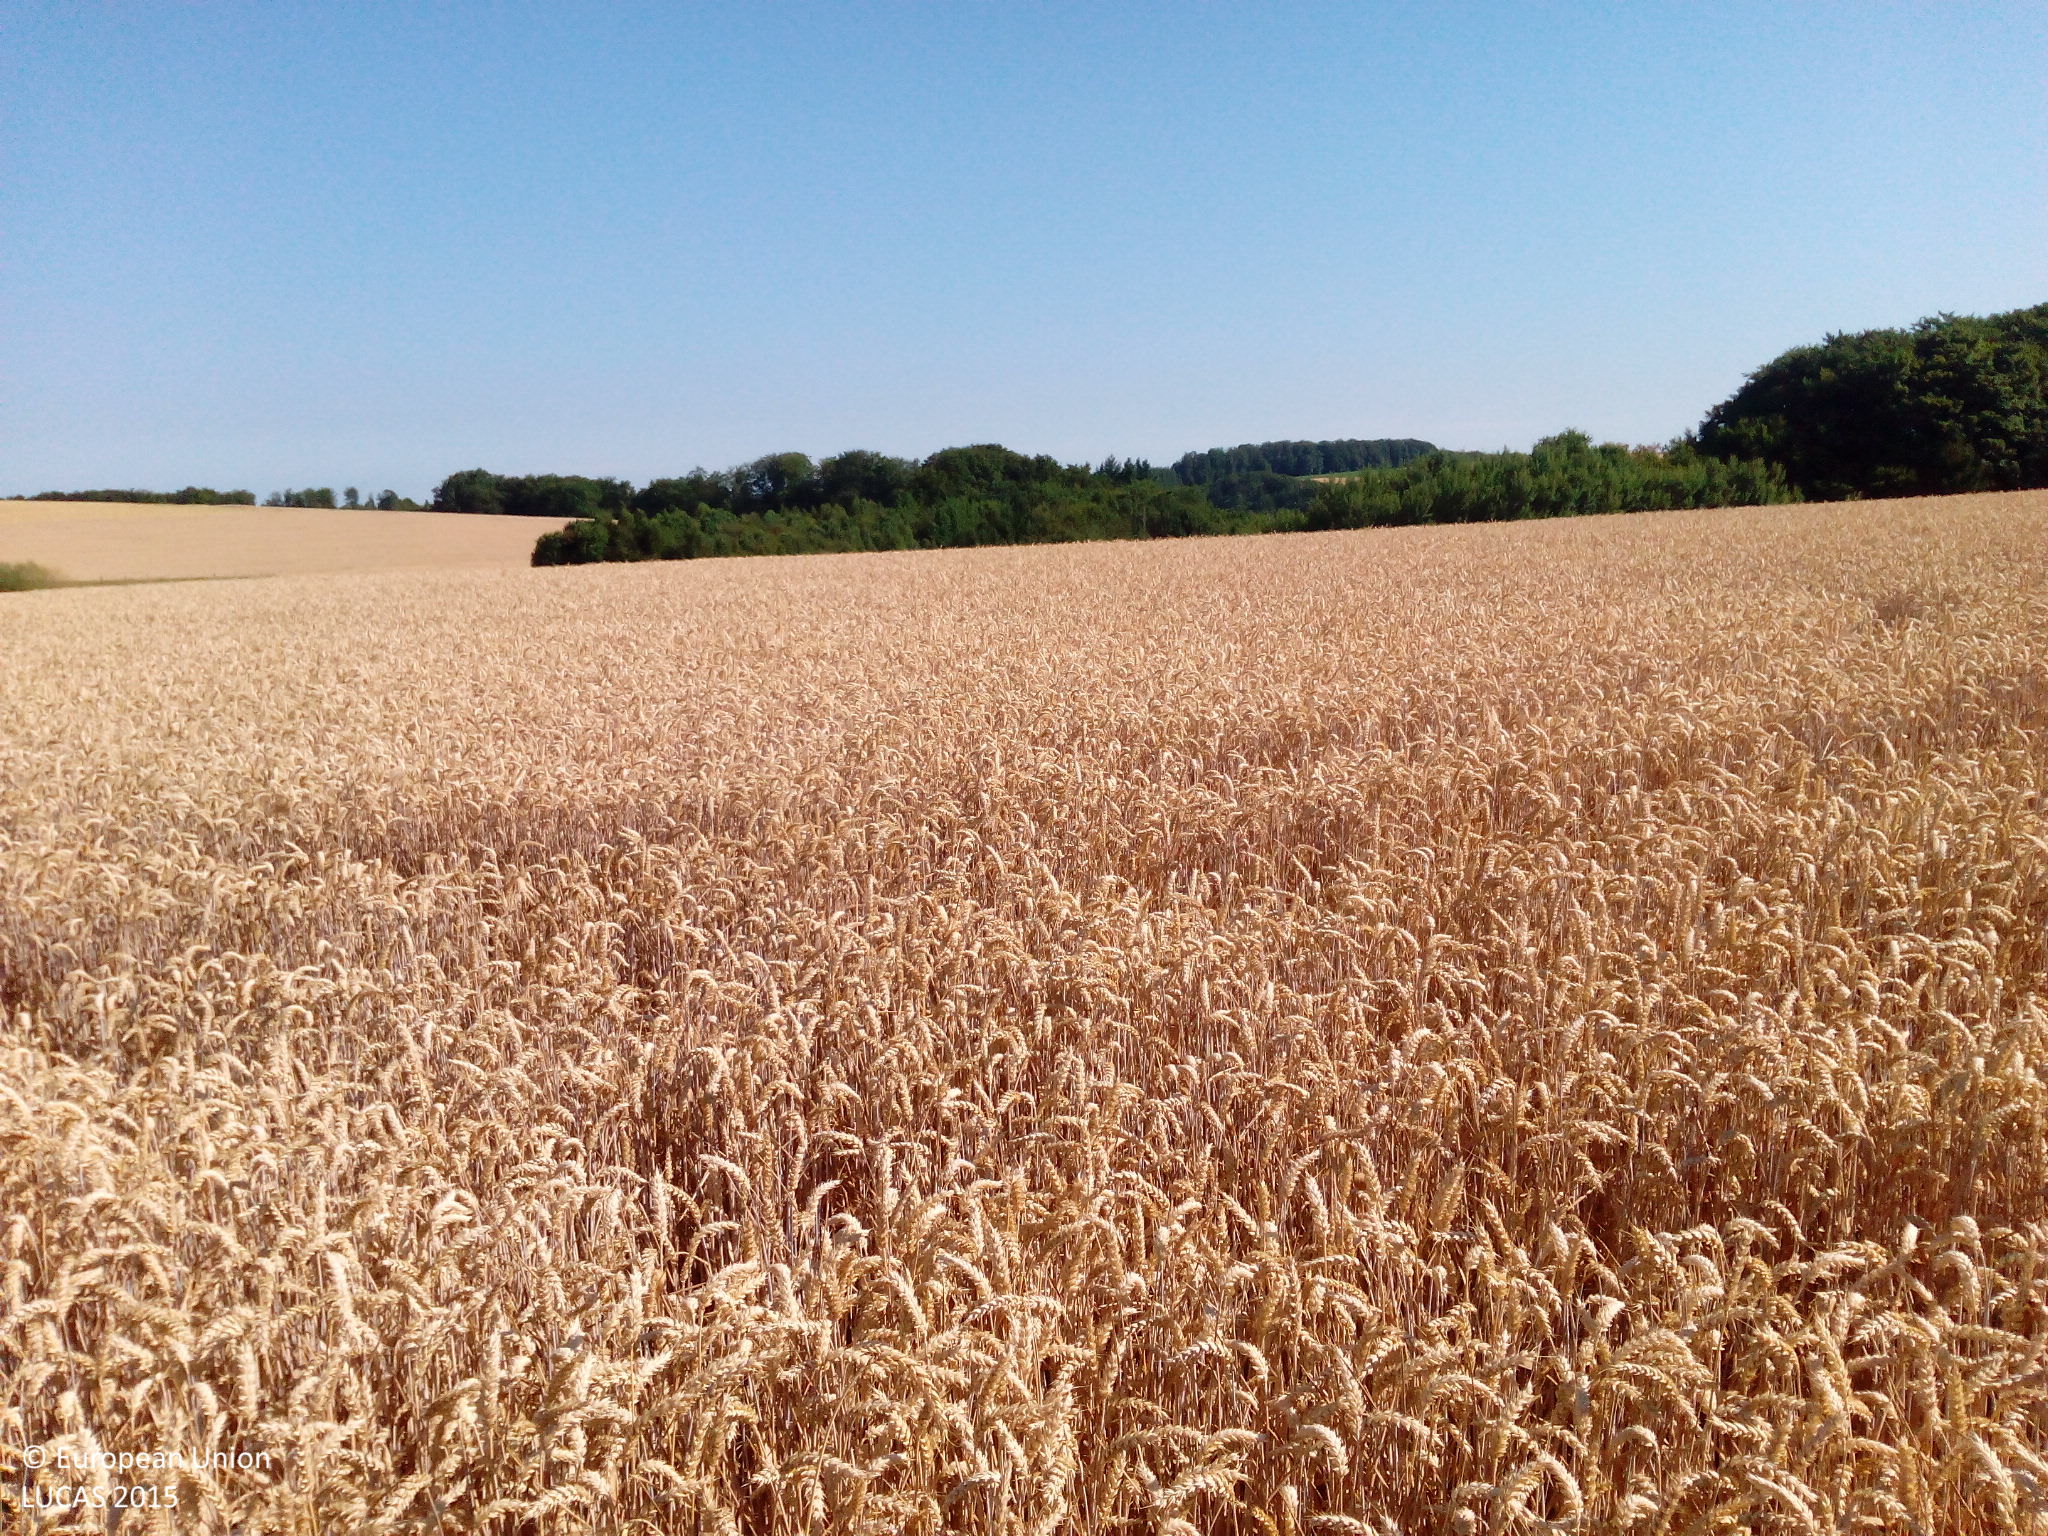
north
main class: Cropland
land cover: Common wheat
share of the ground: > 75 %
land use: Agriculture (excluding fallow land and kitchen gardens)
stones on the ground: < 10 %
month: July
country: DE
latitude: 49.2761
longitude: 7.5401
